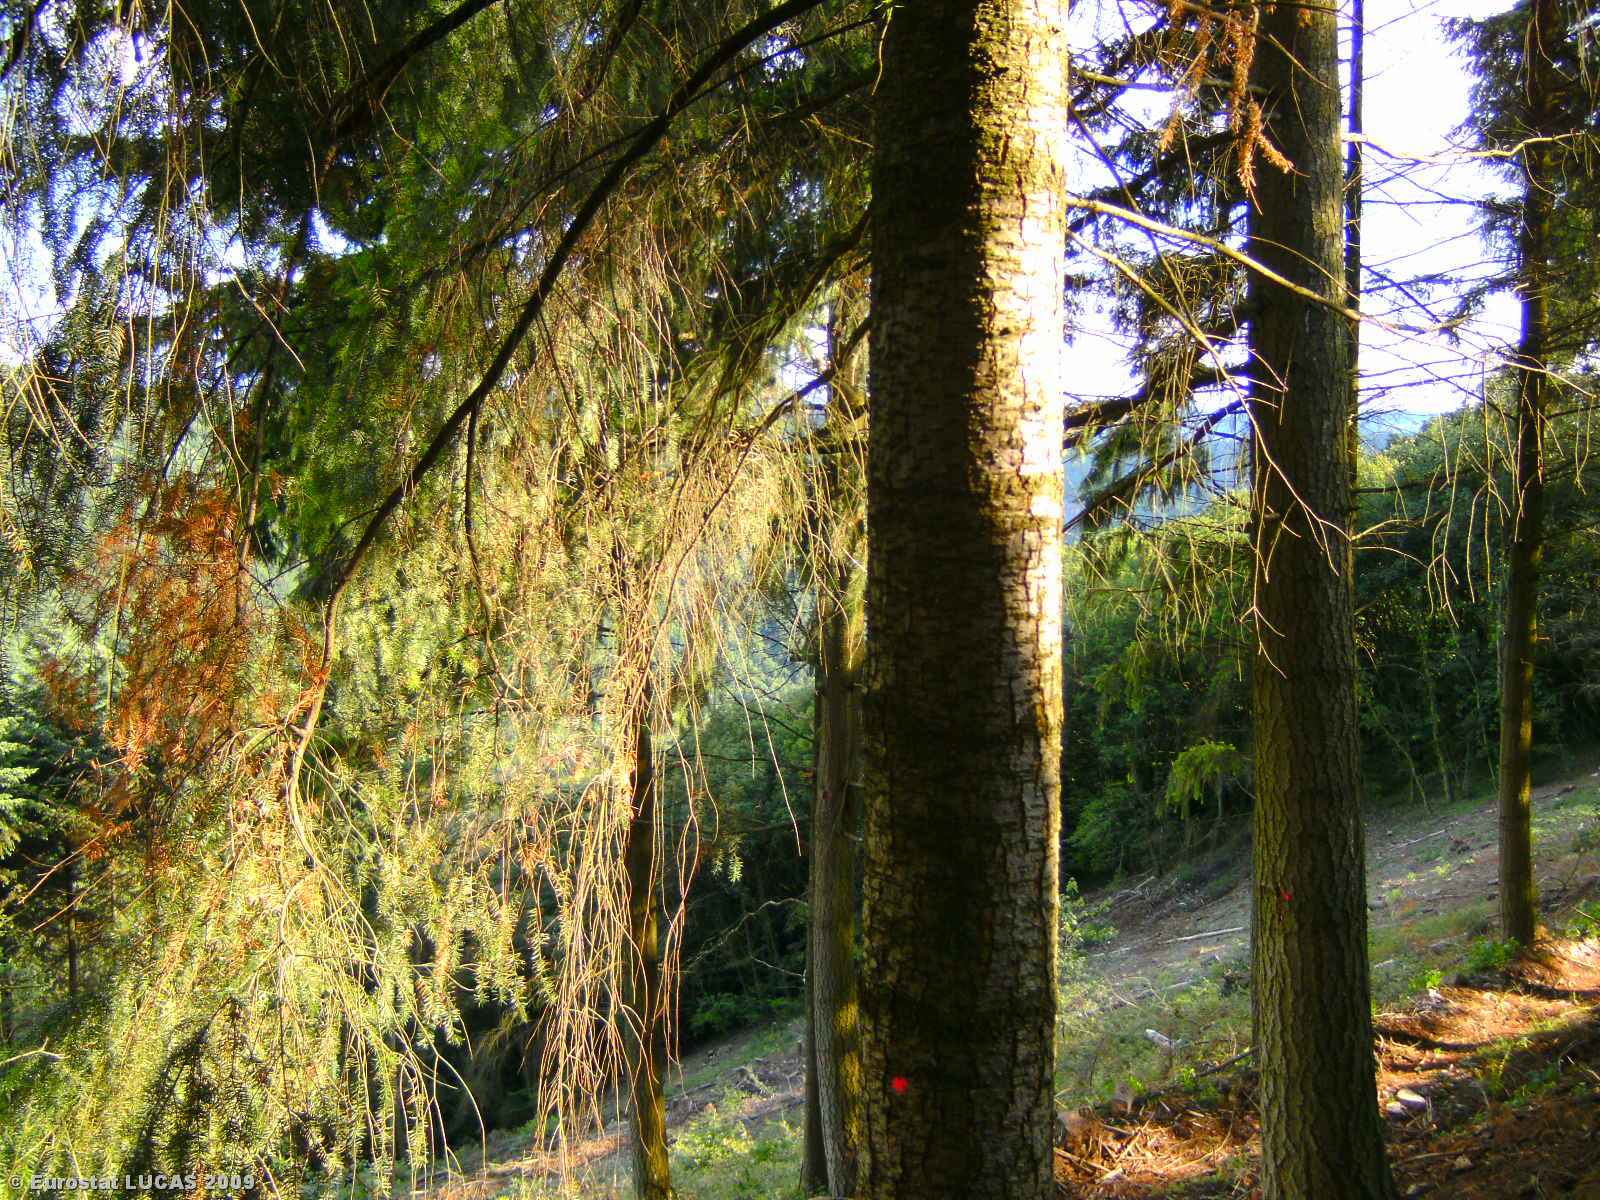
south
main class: Woodland
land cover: Coniferous woodland
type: hemiboreal forest and nemoral coniferous forest and mixed broadleaved-coniferous forest
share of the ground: > 75 %
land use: Forestry
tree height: > 5 m
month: June
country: LU
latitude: 49.9020
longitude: 6.1149
